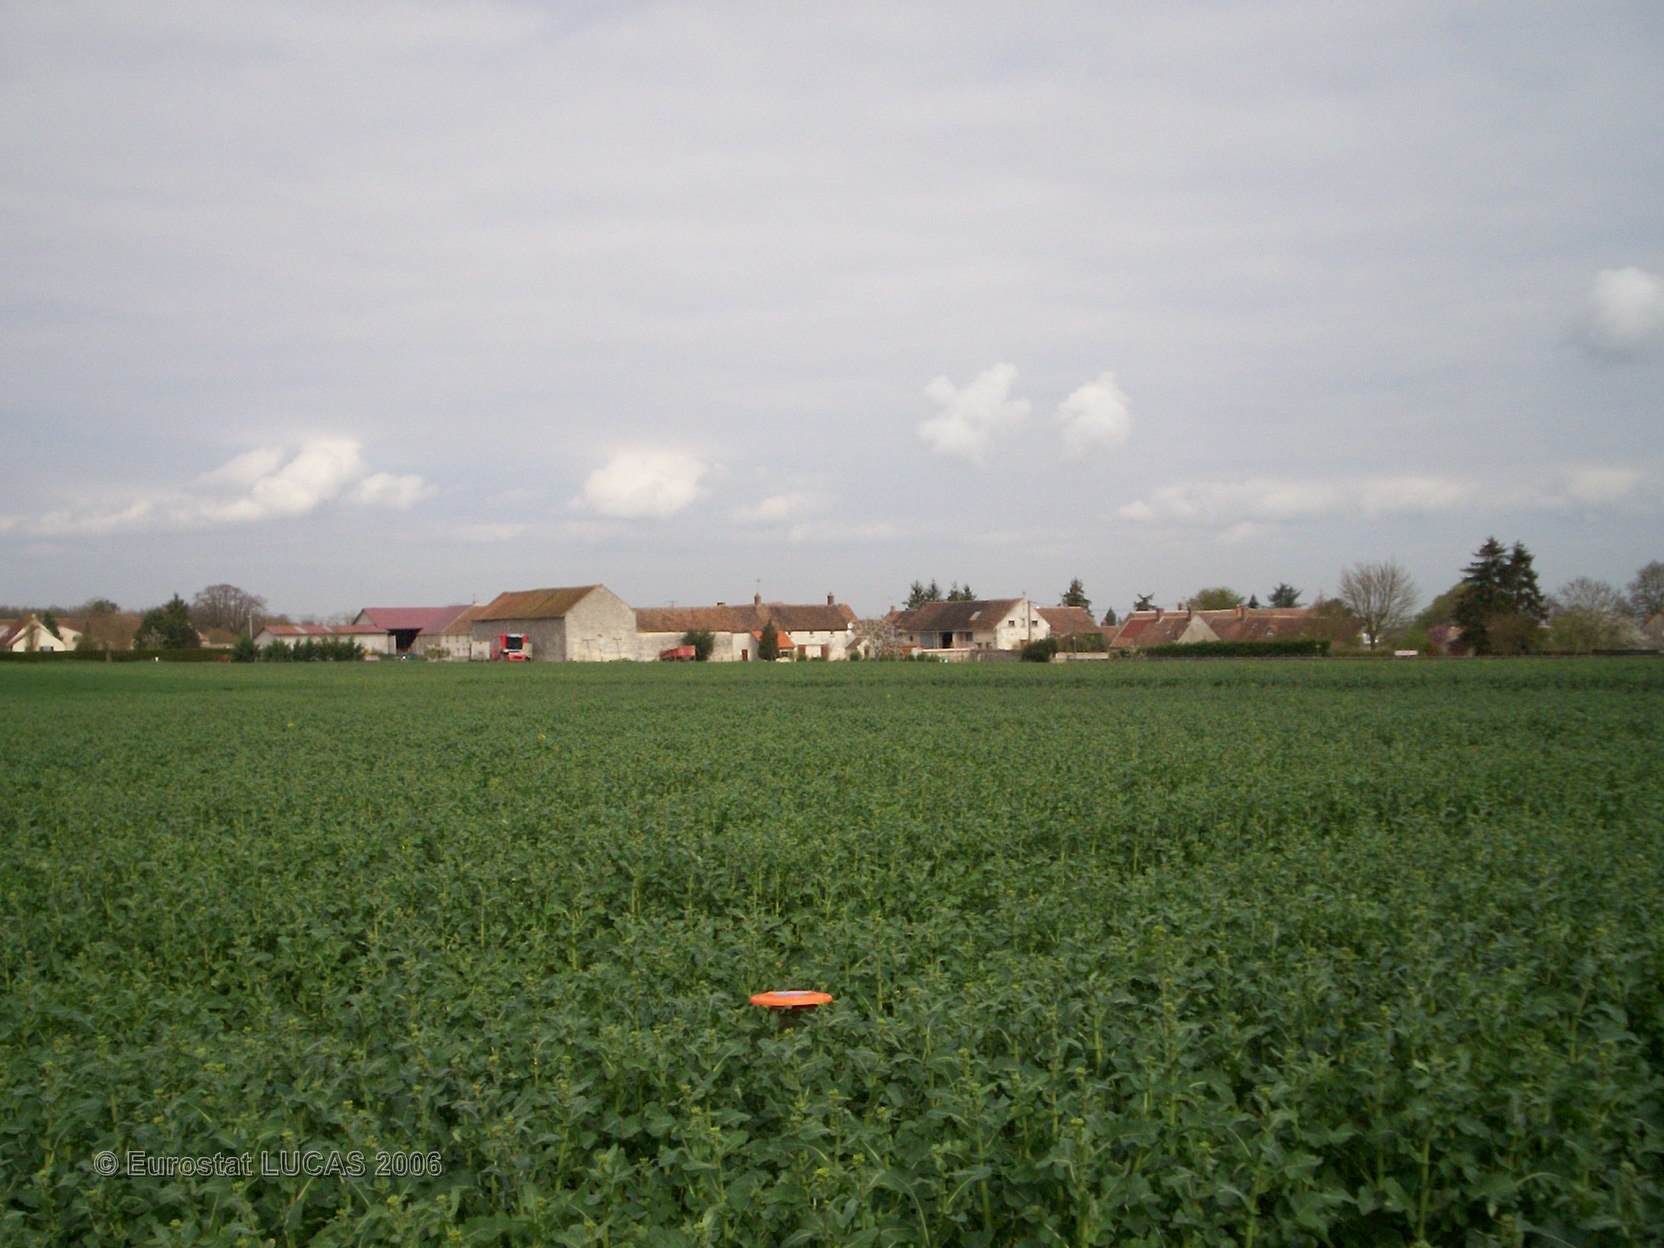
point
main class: Cropland
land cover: Rape and turnip rape
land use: Agriculture (excluding fallow land and kitchen gardens)
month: April
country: FR
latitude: 48.2632
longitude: 2.8655
